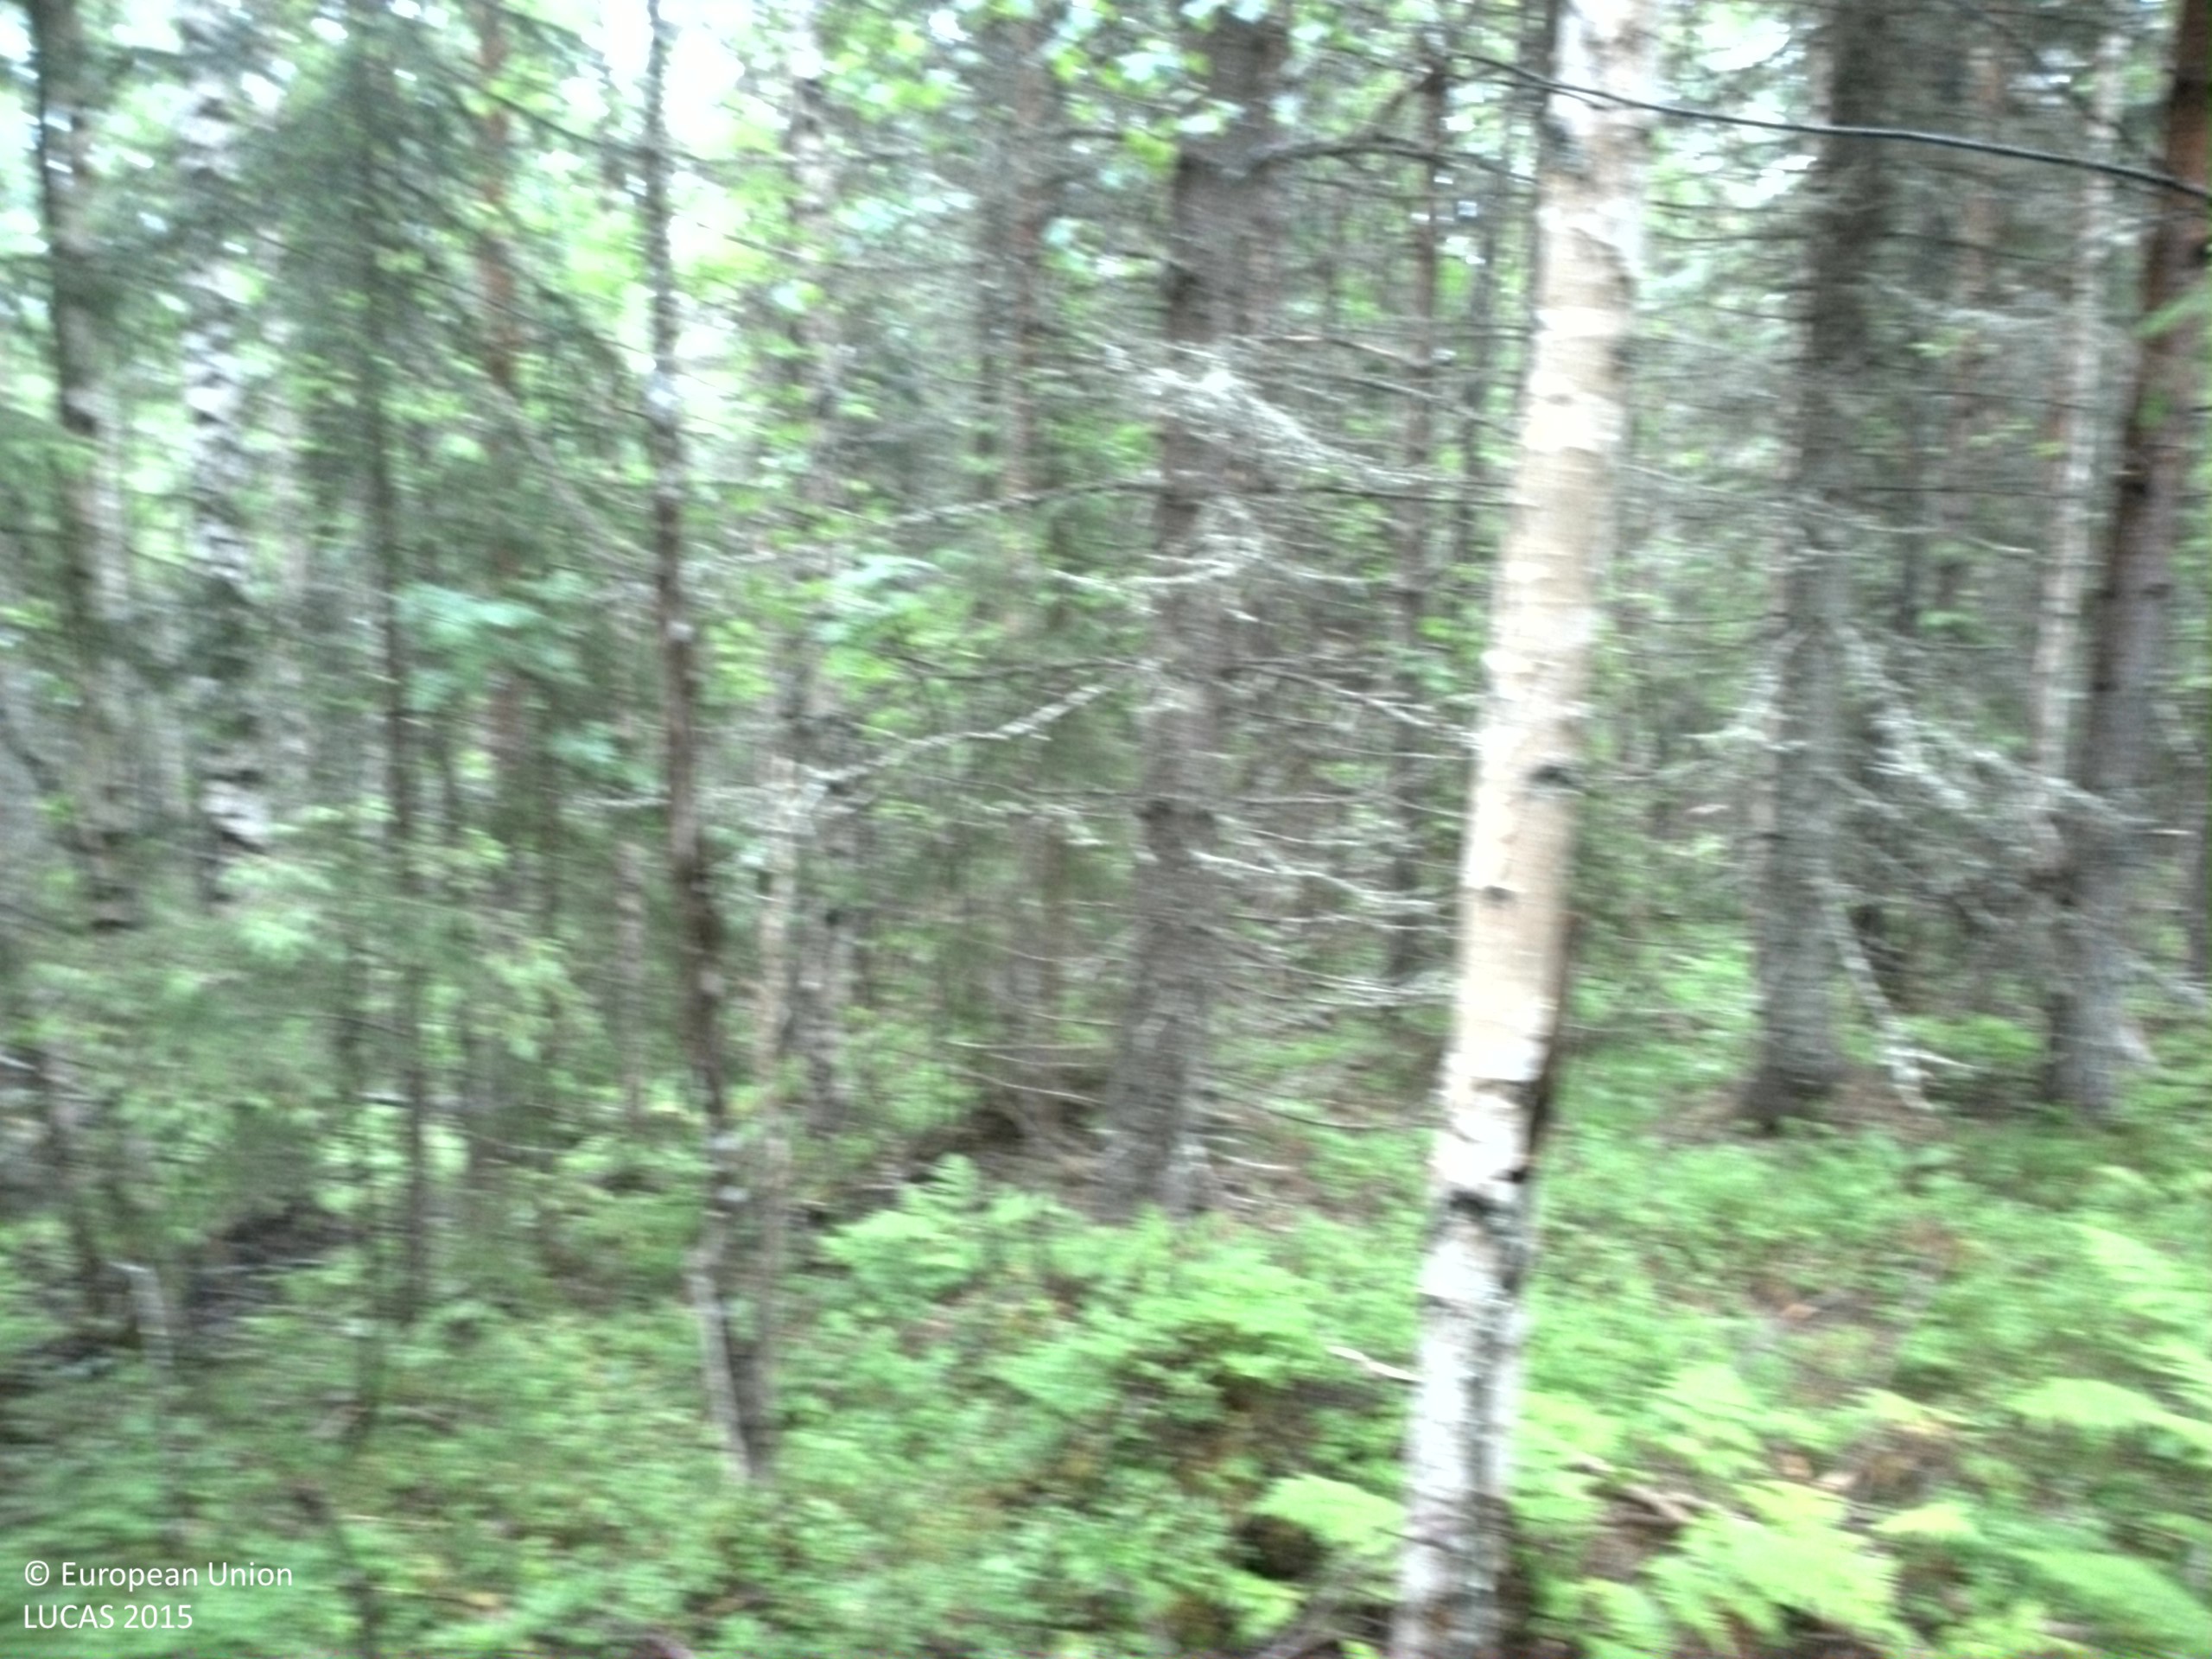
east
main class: Woodland
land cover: Spruce dominated mixed woodland
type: boreal forest
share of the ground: 50 - 75 %
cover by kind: coniferous forest trees 45 %, broadleaved forest trees 15 %, shrubs 15 %, herbaceous plants 15 %
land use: Forestry
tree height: > 5 m
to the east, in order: Spruce dominated mixed woodland; Shrubland without tree cover; Tracks; Pine dominated mixed woodland; Spruce dominated mixed woodland
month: July
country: SE
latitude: 63.1477
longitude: 17.1792
